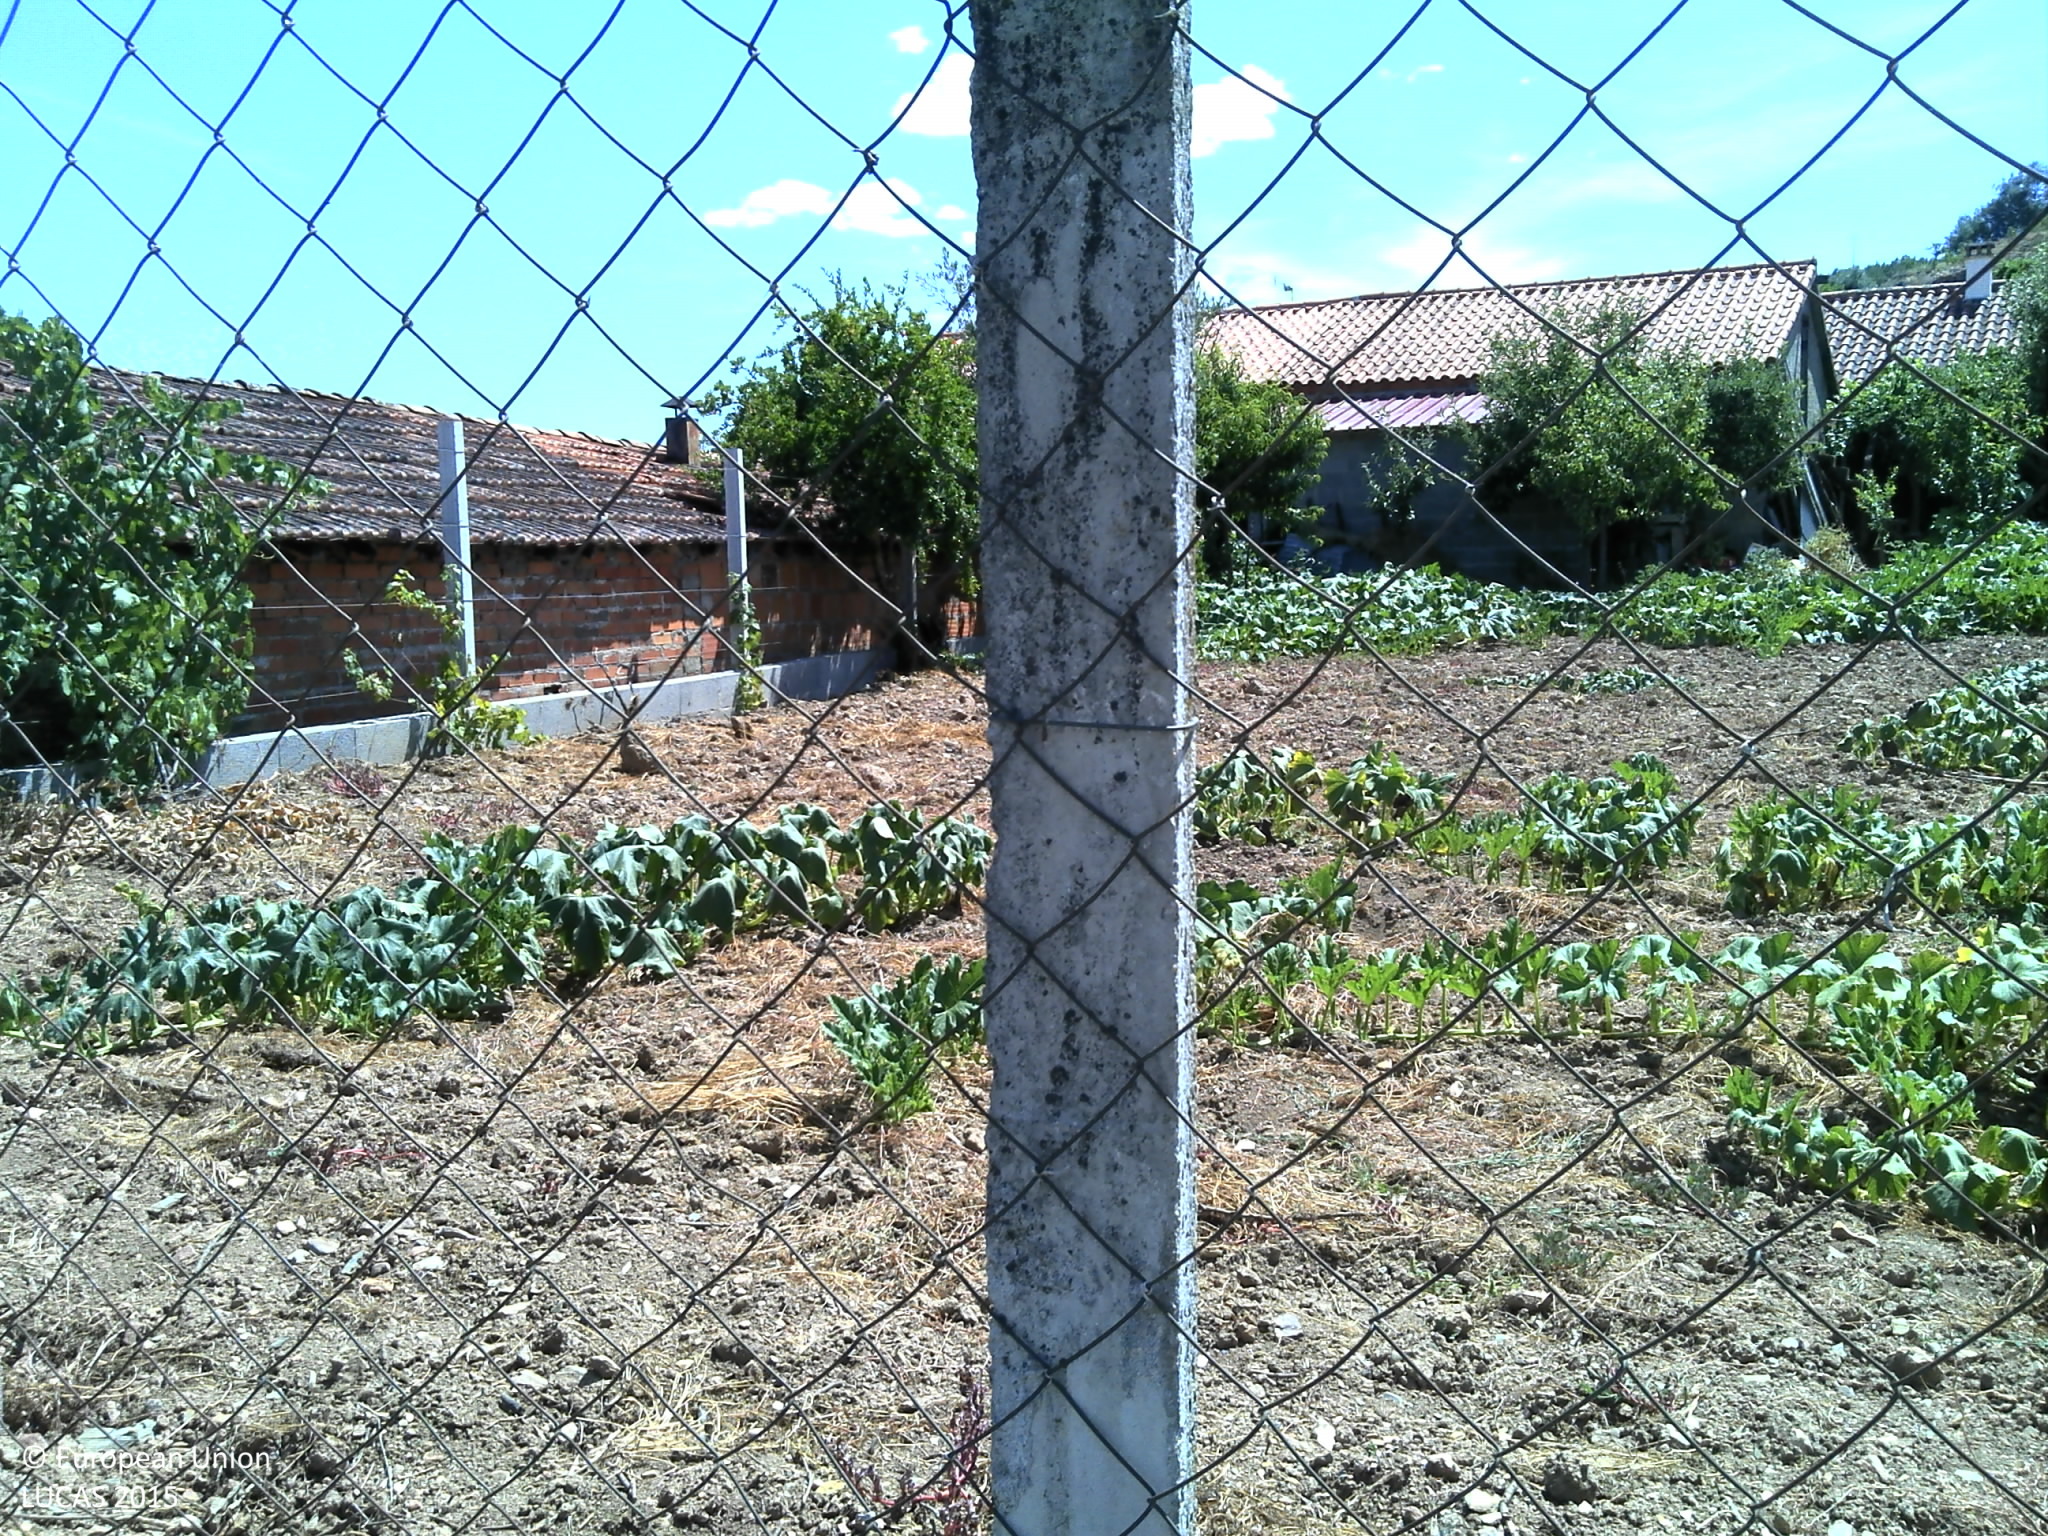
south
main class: Cropland
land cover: Apple fruit
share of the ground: 10 - 25 %
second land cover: Other fresh vegetables
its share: 10 - 25 %
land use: Kitchen garden
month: July
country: PT
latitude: 39.8150
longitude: -7.7566
